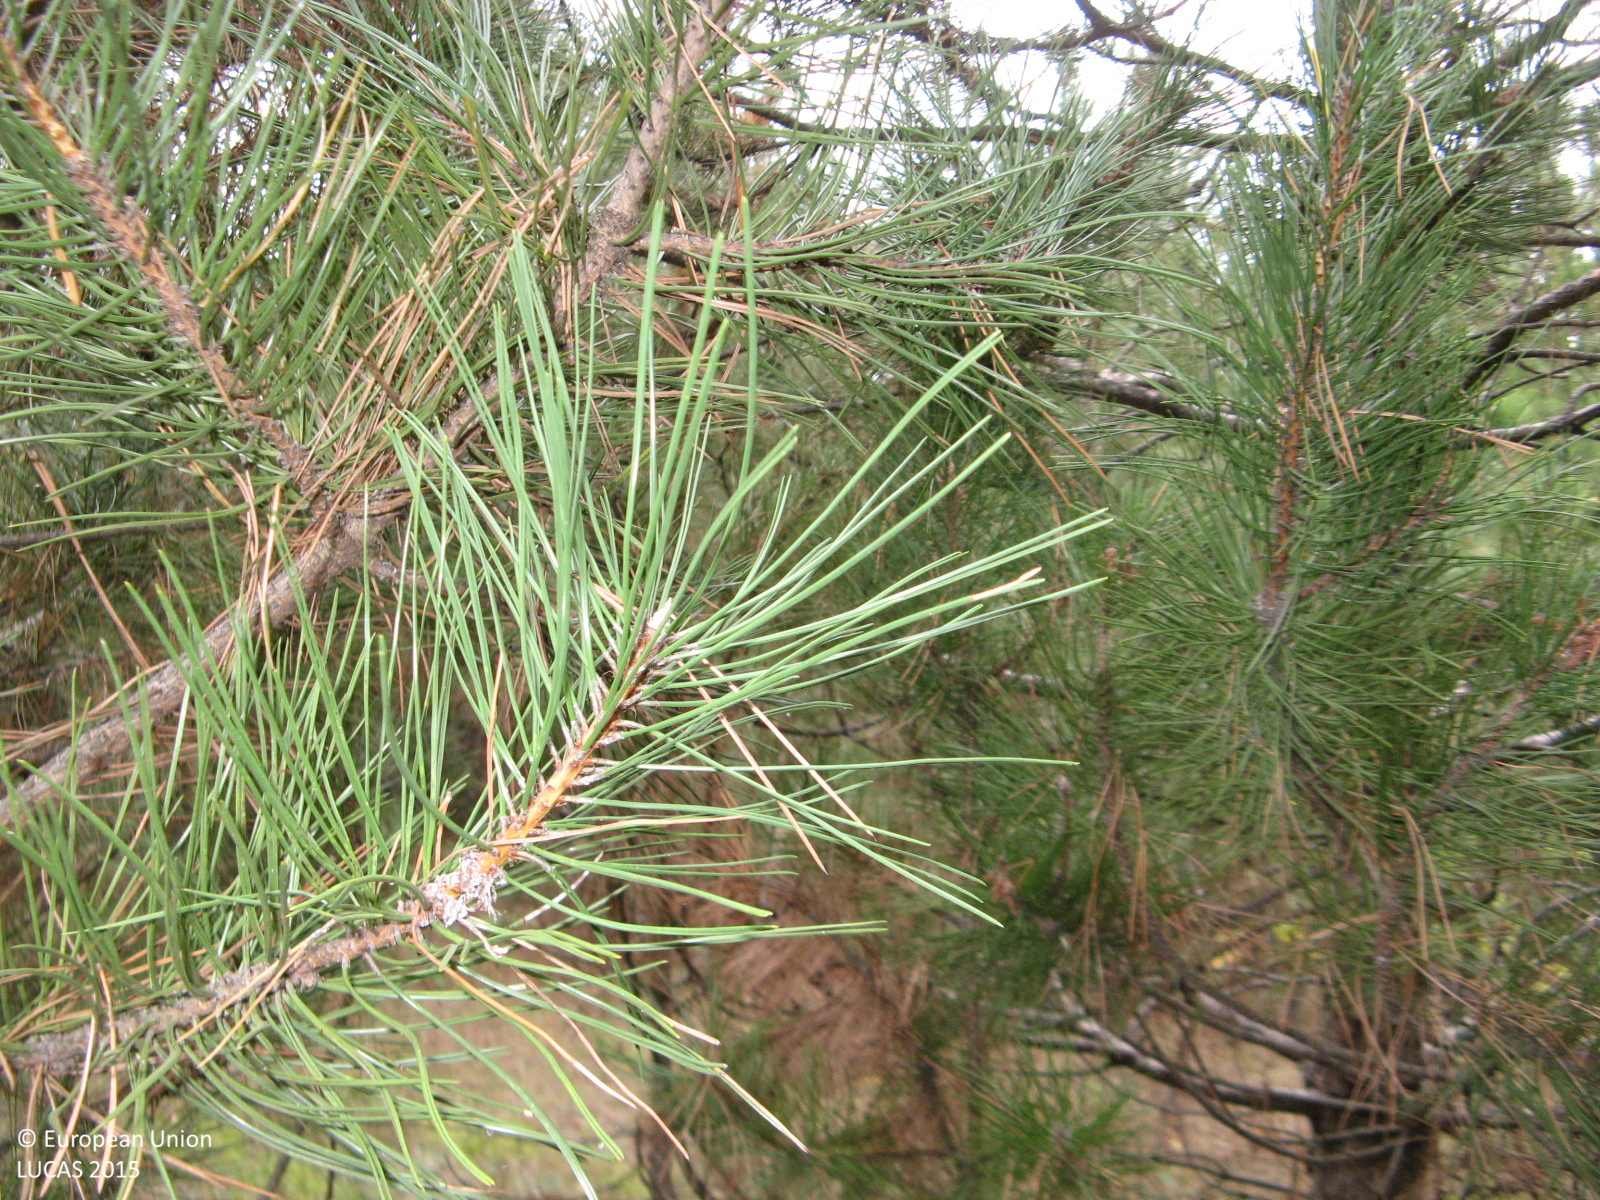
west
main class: Woodland
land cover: Pine dominated mixed woodland
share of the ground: > 75 %
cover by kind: coniferous forest trees 75 %, broadleaved forest trees 25 %
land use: Forestry
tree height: < 5 m
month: November
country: BG
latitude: 41.4058
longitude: 25.3286
